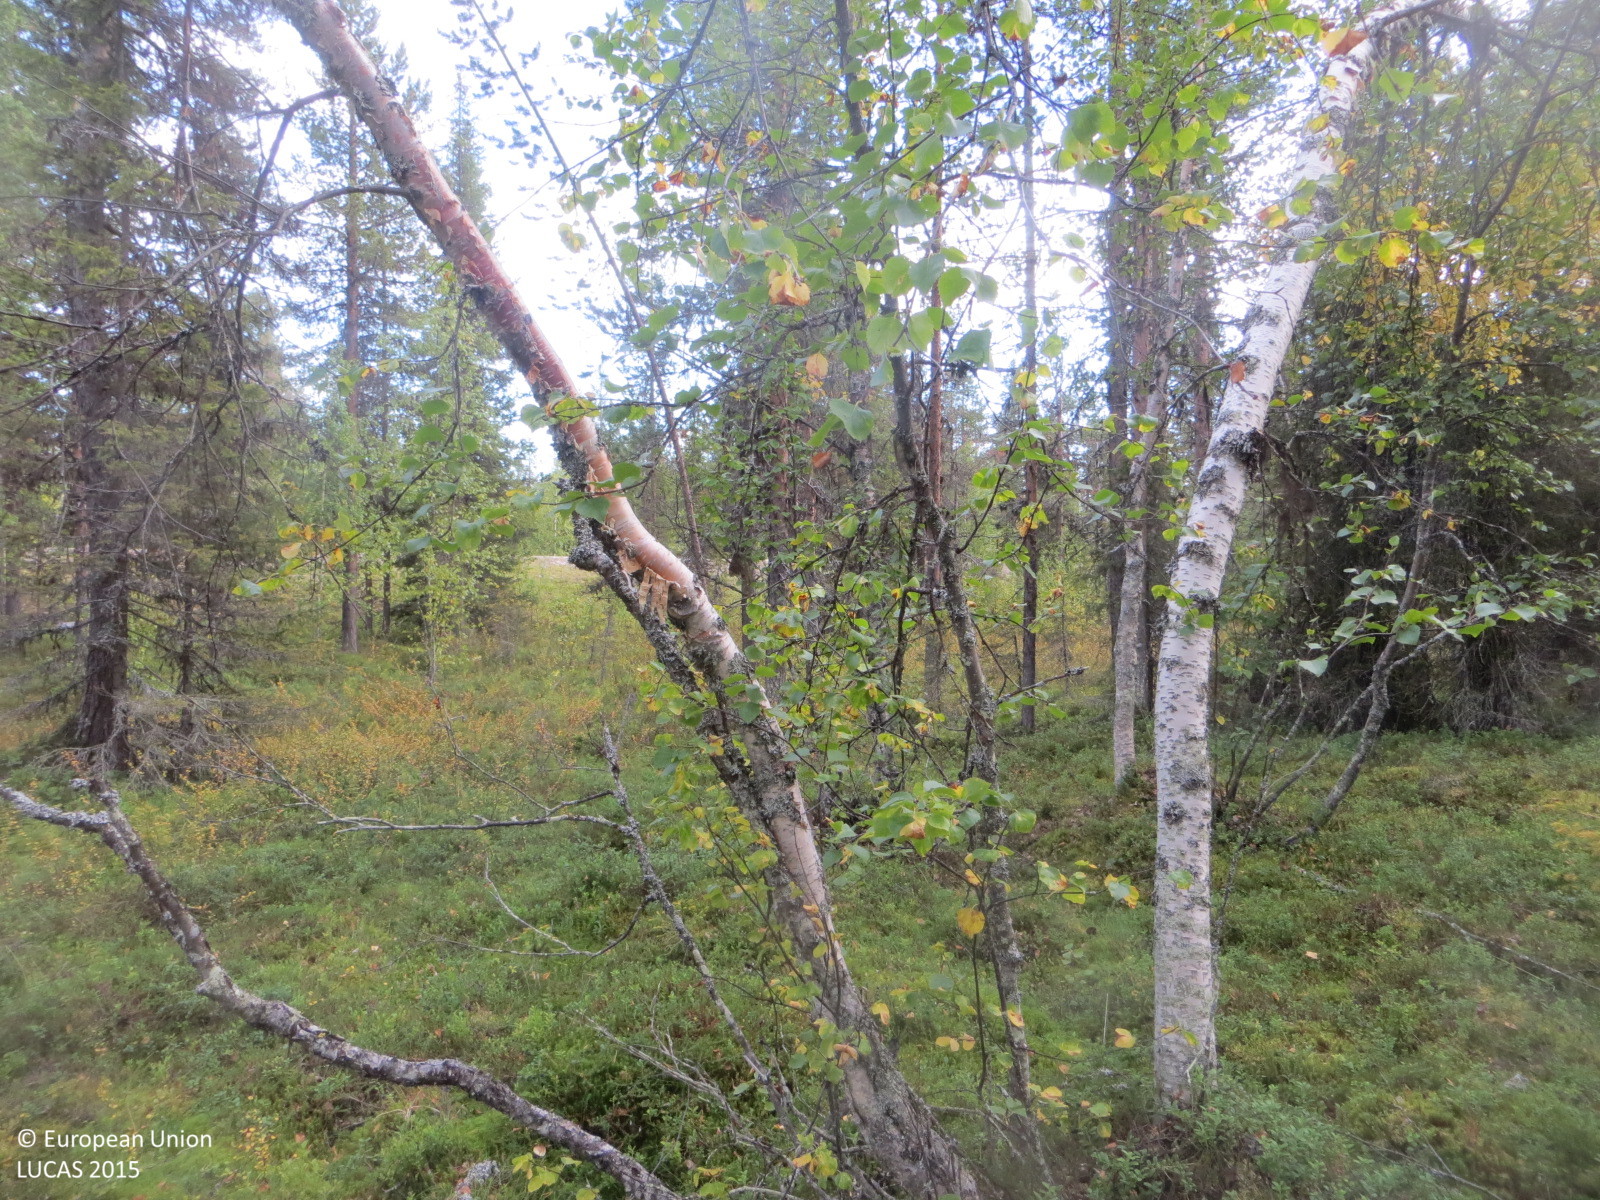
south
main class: Woodland
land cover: Other mixed woodland
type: boreal forest
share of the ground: 50 - 75 %
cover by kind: shrubs 50 %, coniferous forest trees 30 %, broadleaved forest trees 20 %
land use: Forestry
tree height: > 5 m
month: September
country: FI
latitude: 67.9046
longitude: 24.2430
